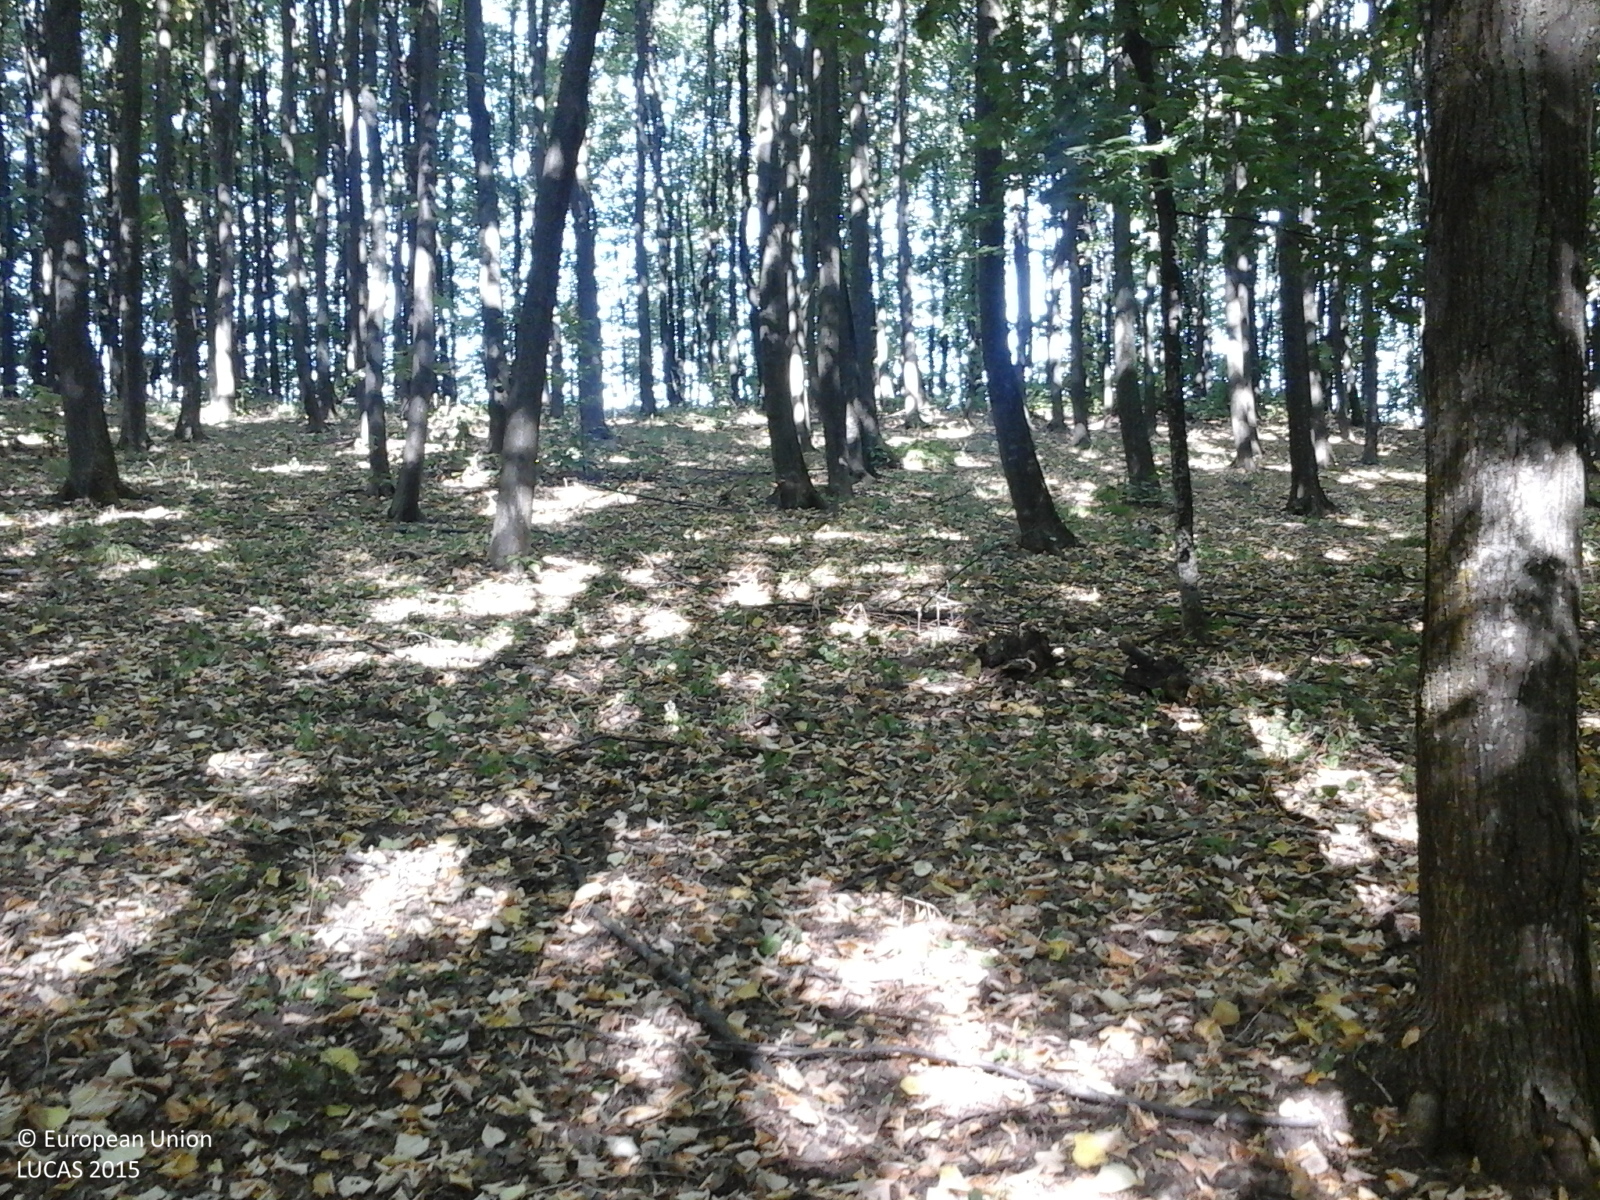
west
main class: Woodland
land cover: Broadleaved woodland
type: thermophilous deciduous forest
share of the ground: > 75 %
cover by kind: broadleaved forest trees 100 %
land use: Forestry
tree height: > 5 m
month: July
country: RO
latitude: 46.4505
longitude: 27.3286
